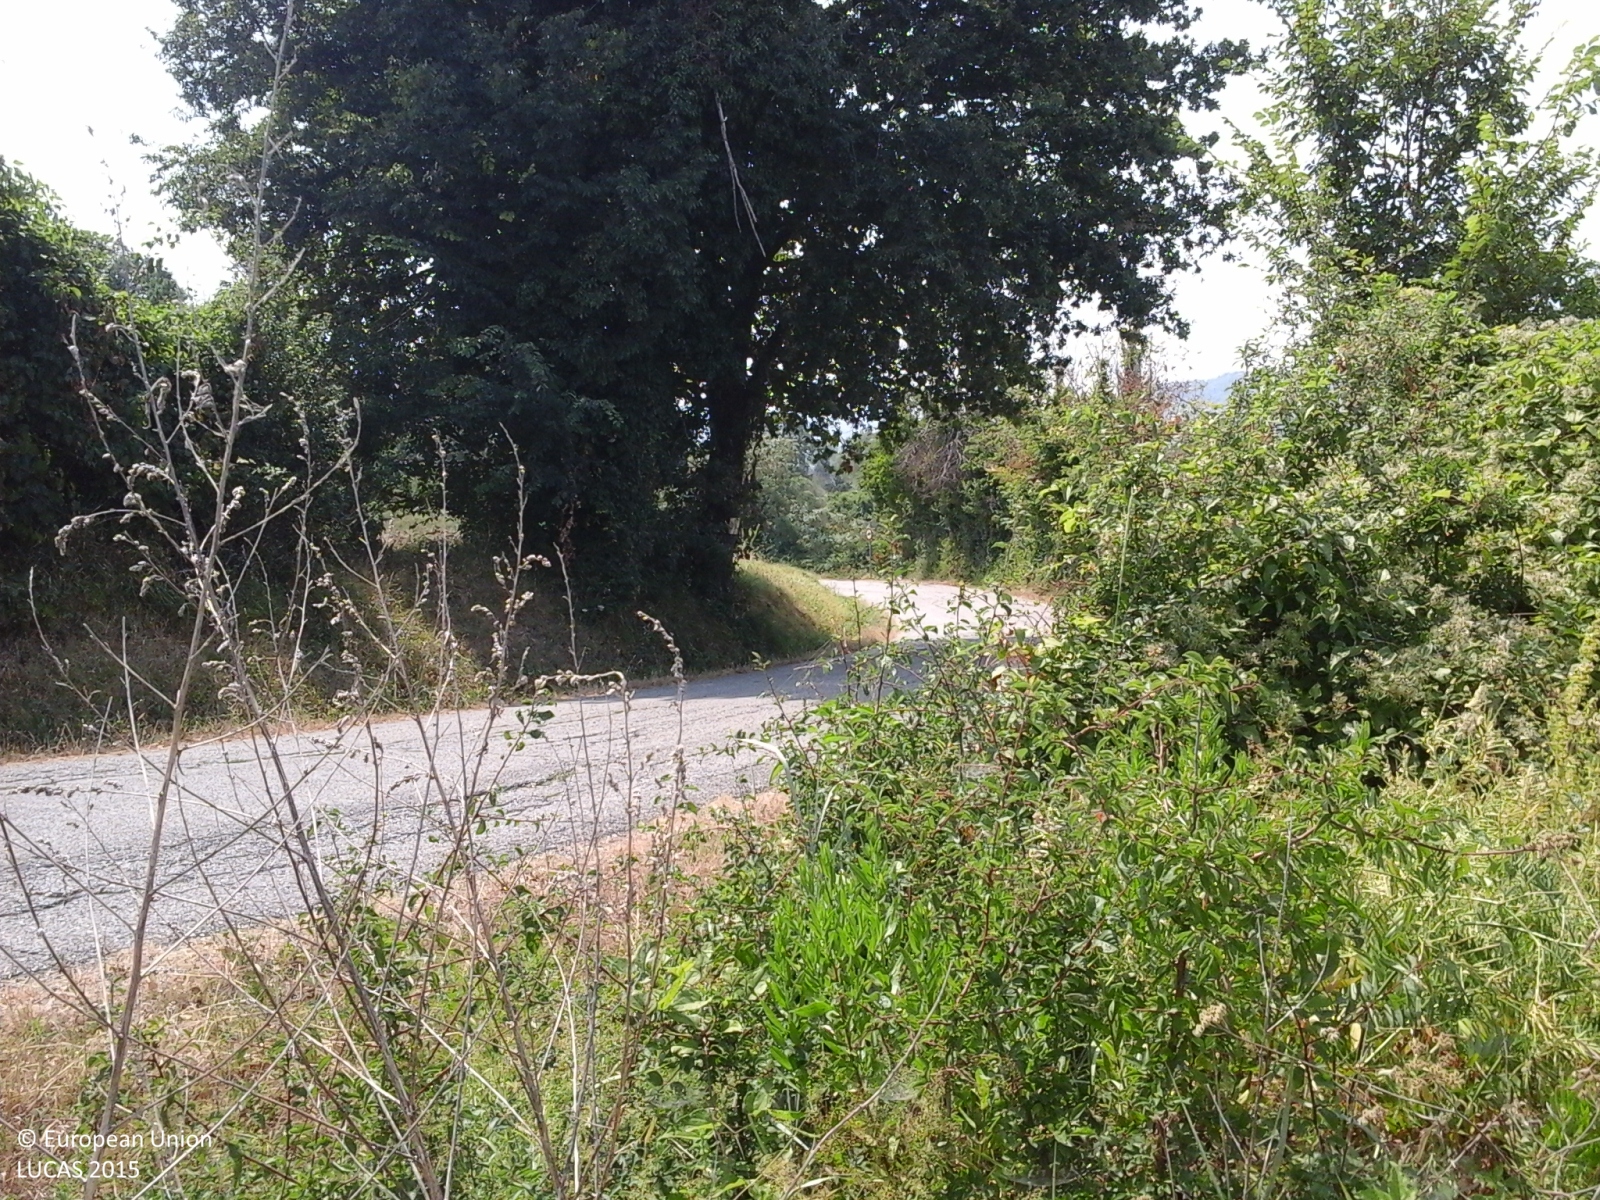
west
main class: Cropland
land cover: Other leguminous and mixtures for fodder
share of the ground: > 75 %
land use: Agriculture (excluding fallow land and kitchen gardens)
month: July
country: IT
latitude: 44.0352
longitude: 12.3529
